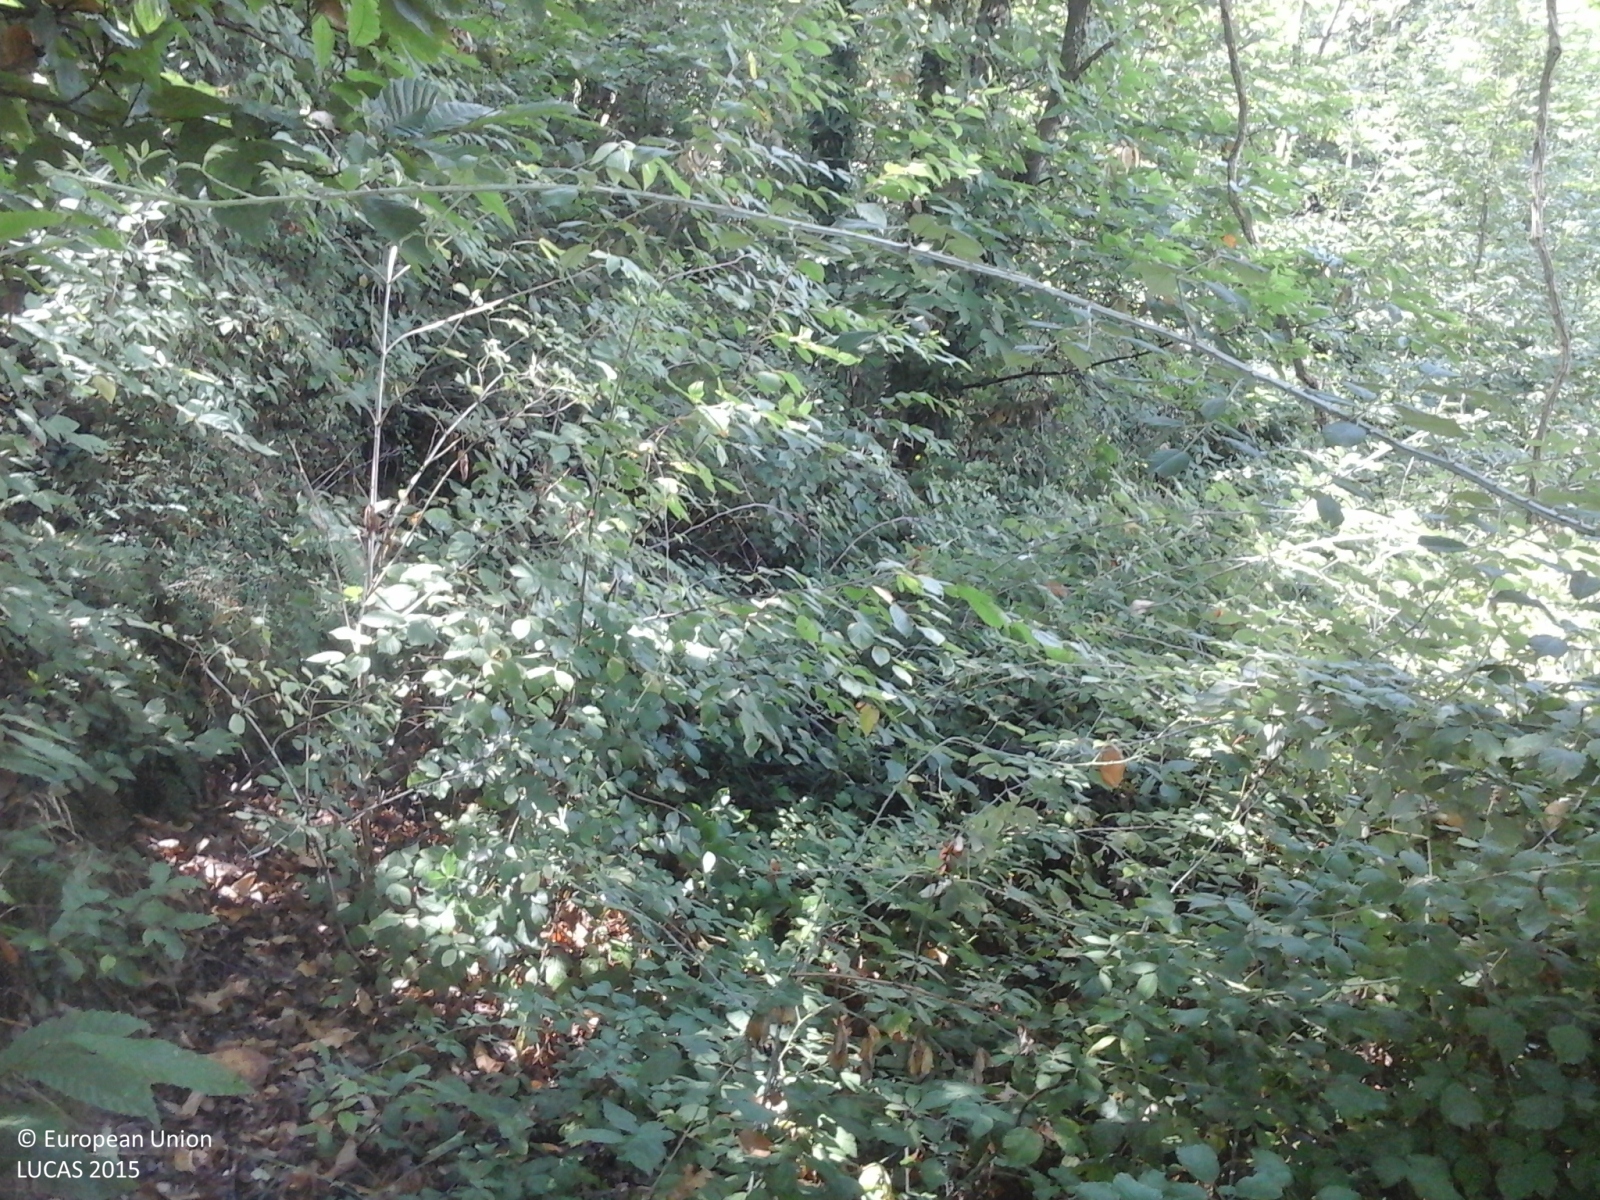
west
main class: Woodland
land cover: Broadleaved woodland
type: thermophilous deciduous forest
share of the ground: > 75 %
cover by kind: broadleaved forest trees 100 %
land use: Forestry
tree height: > 5 m
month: August
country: IT
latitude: 43.8230
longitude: 10.9549
